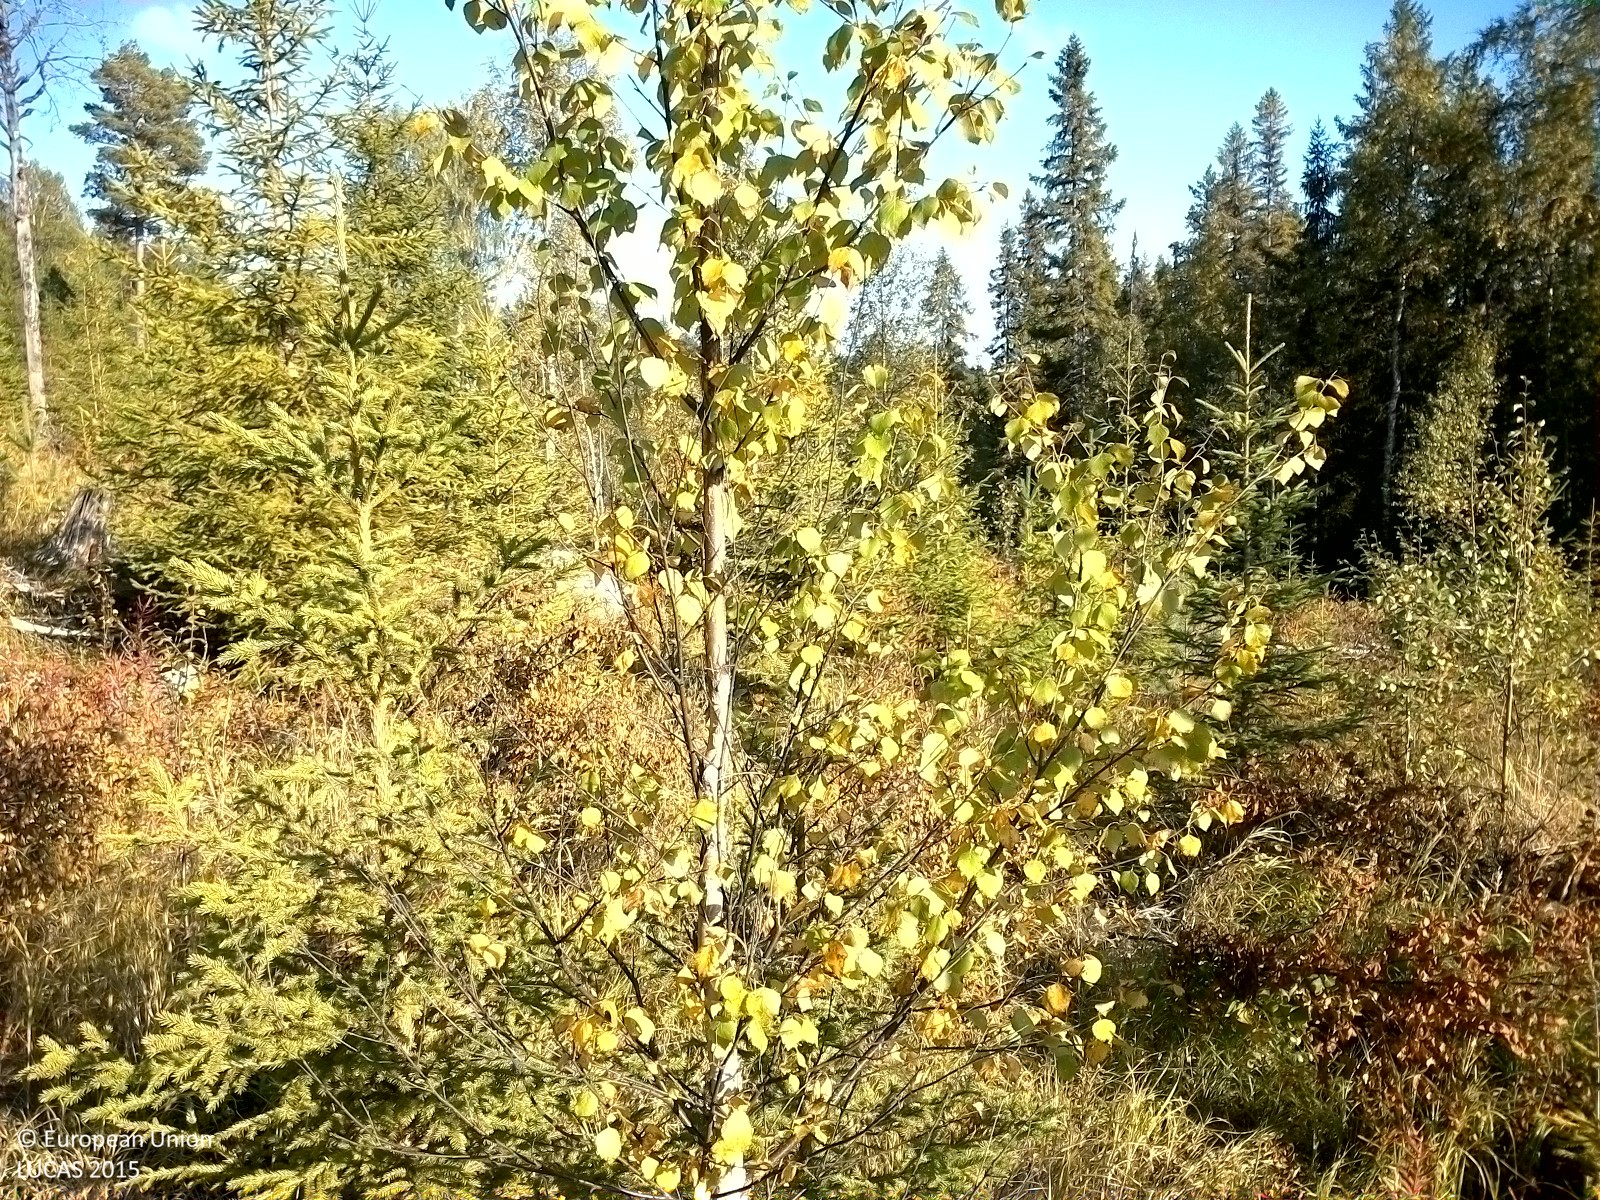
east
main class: Woodland
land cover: Other mixed woodland
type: boreal forest
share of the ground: 25 - 50 %
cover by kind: herbaceous plants 70 %, coniferous forest trees 20 %, broadleaved forest trees 10 %
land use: Forestry
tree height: < 5 m
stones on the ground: < 10 %
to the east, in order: Other mixed woodland; Spruce dominated mixed woodland; Spruce dominated coniferous woodland; Tracks; Other mixed woodland
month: September
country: SE
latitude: 62.5741
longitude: 16.2257
